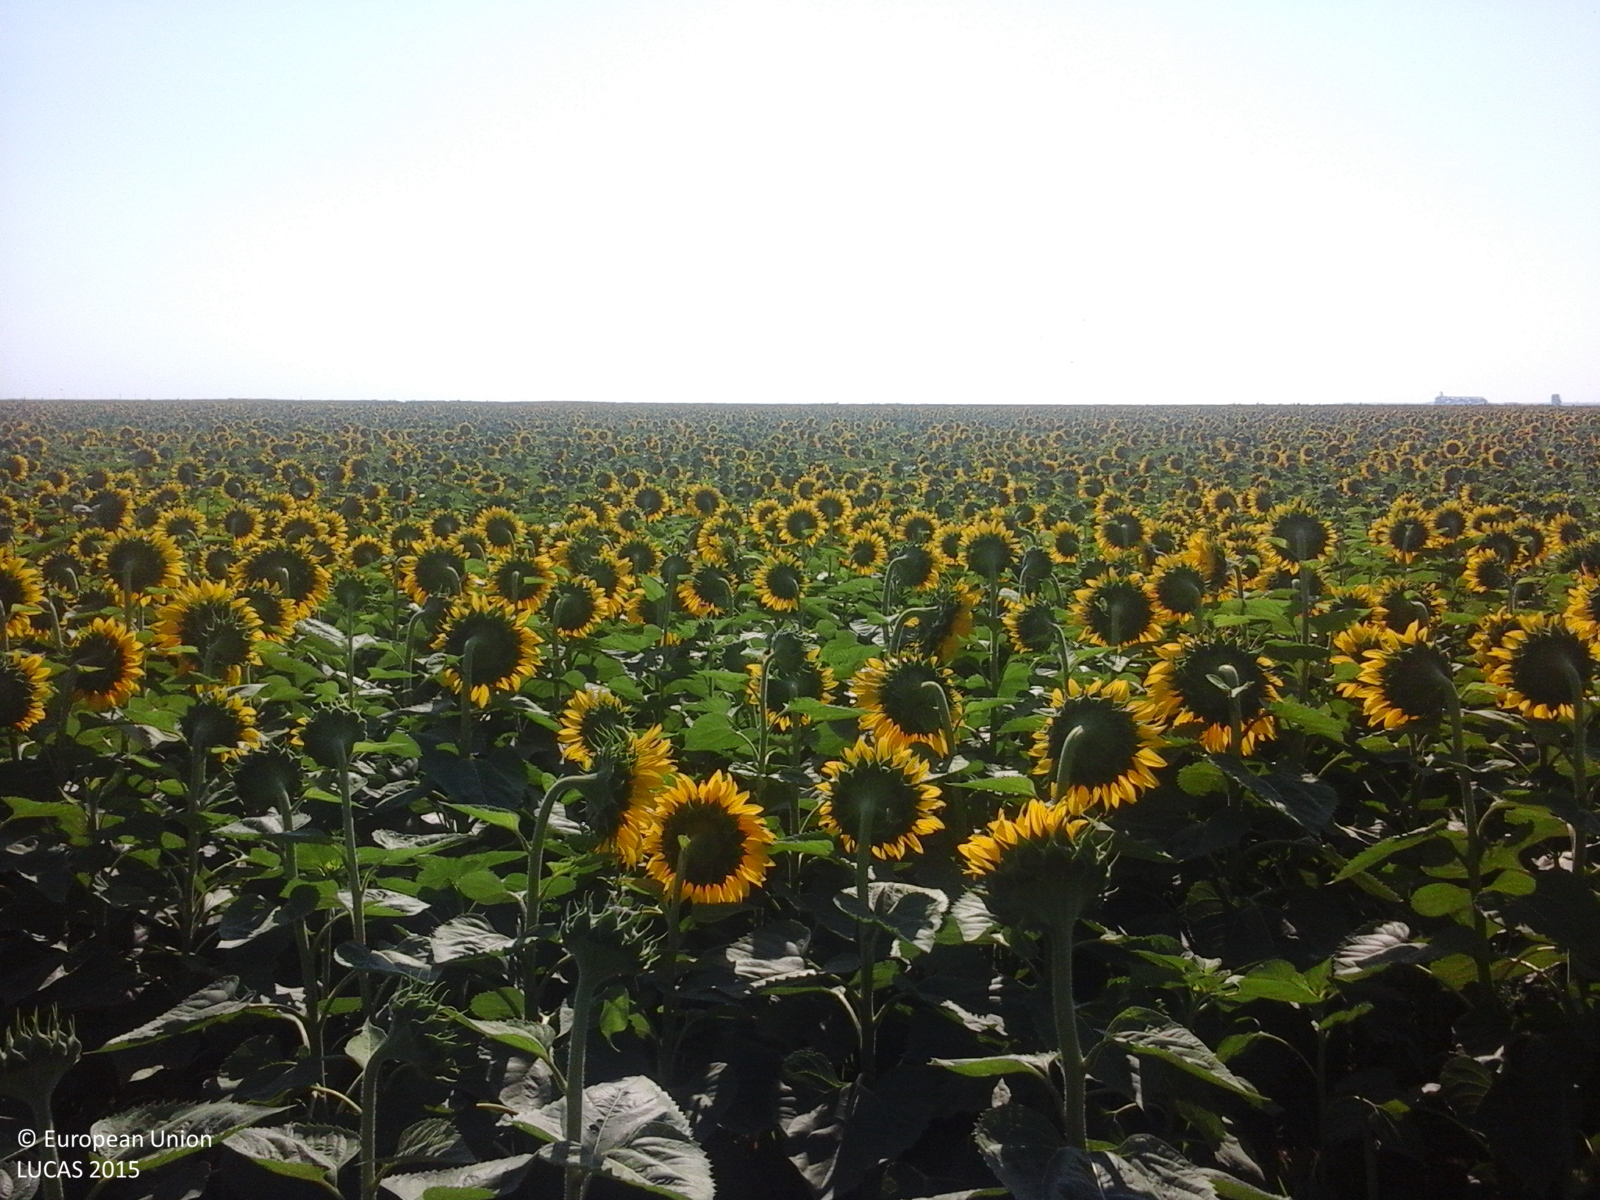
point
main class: Cropland
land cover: Sunflower
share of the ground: > 75 %
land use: Agriculture (excluding fallow land and kitchen gardens)
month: July
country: RO
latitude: 44.1322
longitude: 25.3712
